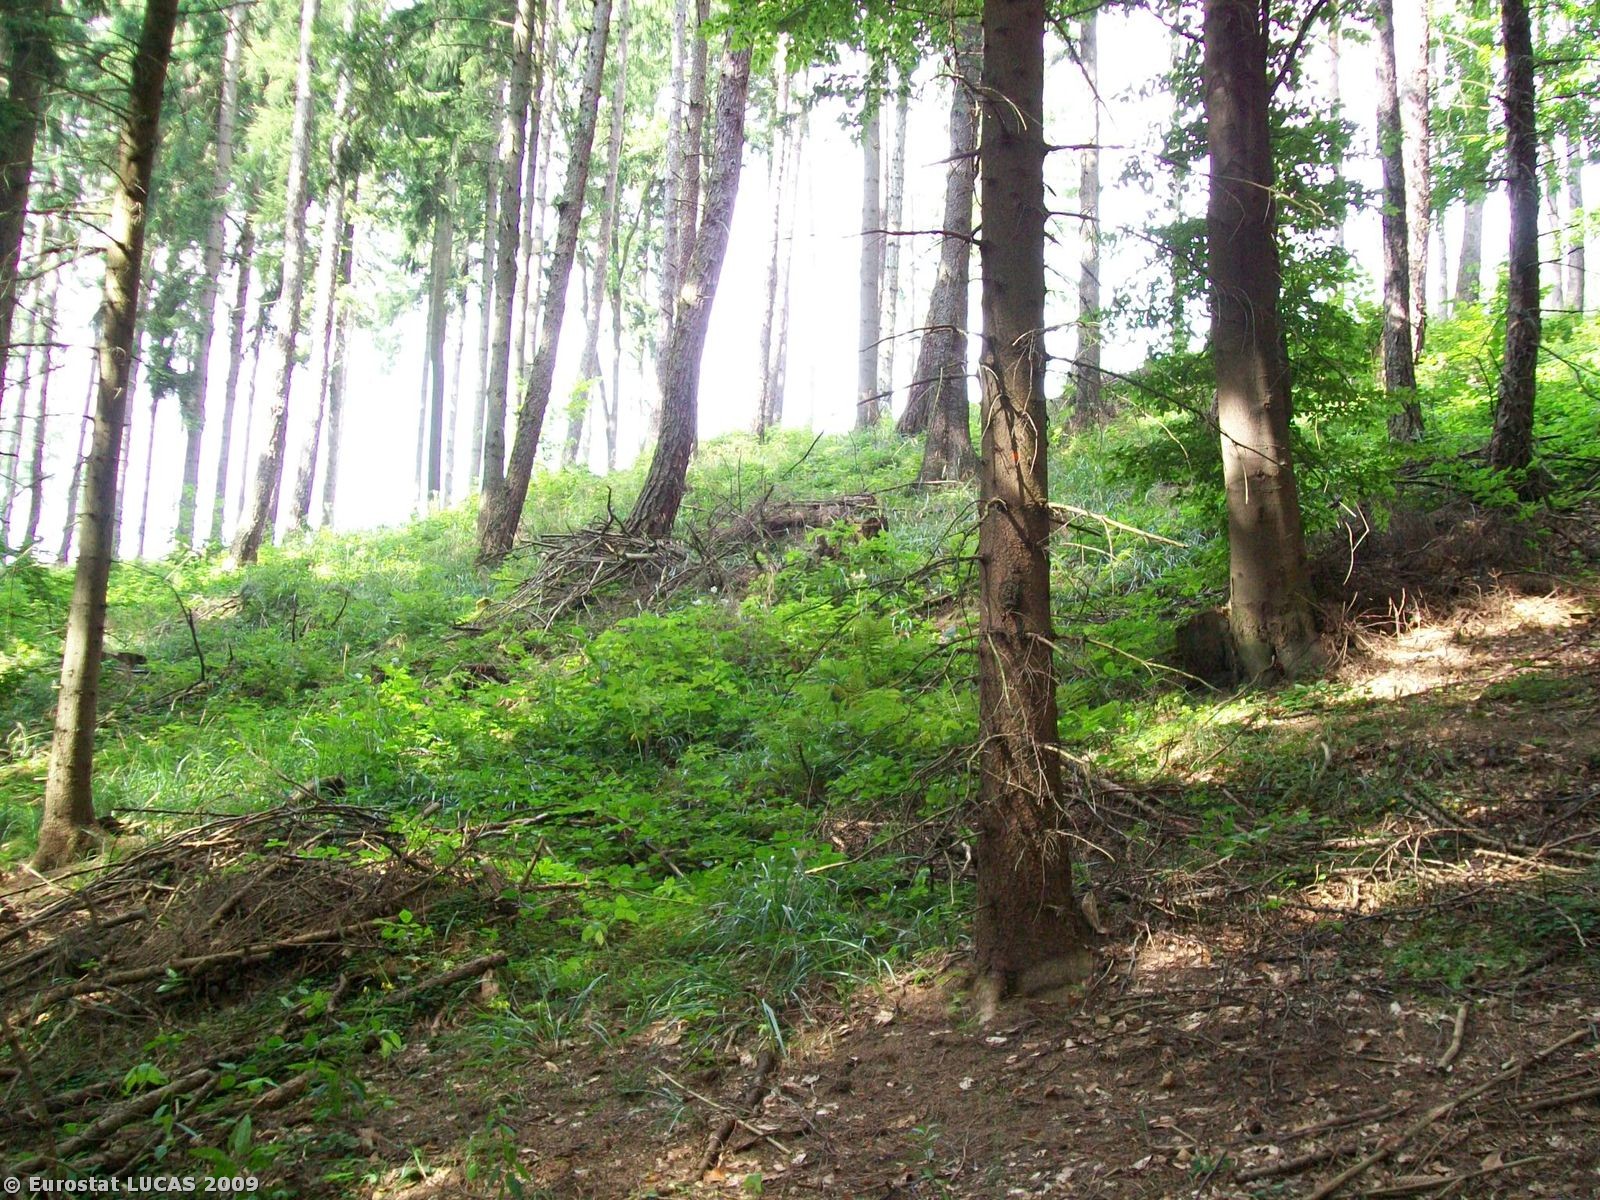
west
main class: Woodland
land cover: Mixed woodland
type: hemiboreal forest and nemoral coniferous forest and mixed broadleaved-coniferous forest
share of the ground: > 75 %
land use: Forestry
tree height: > 5 m
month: September
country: PL
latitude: 50.4726
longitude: 16.7297
